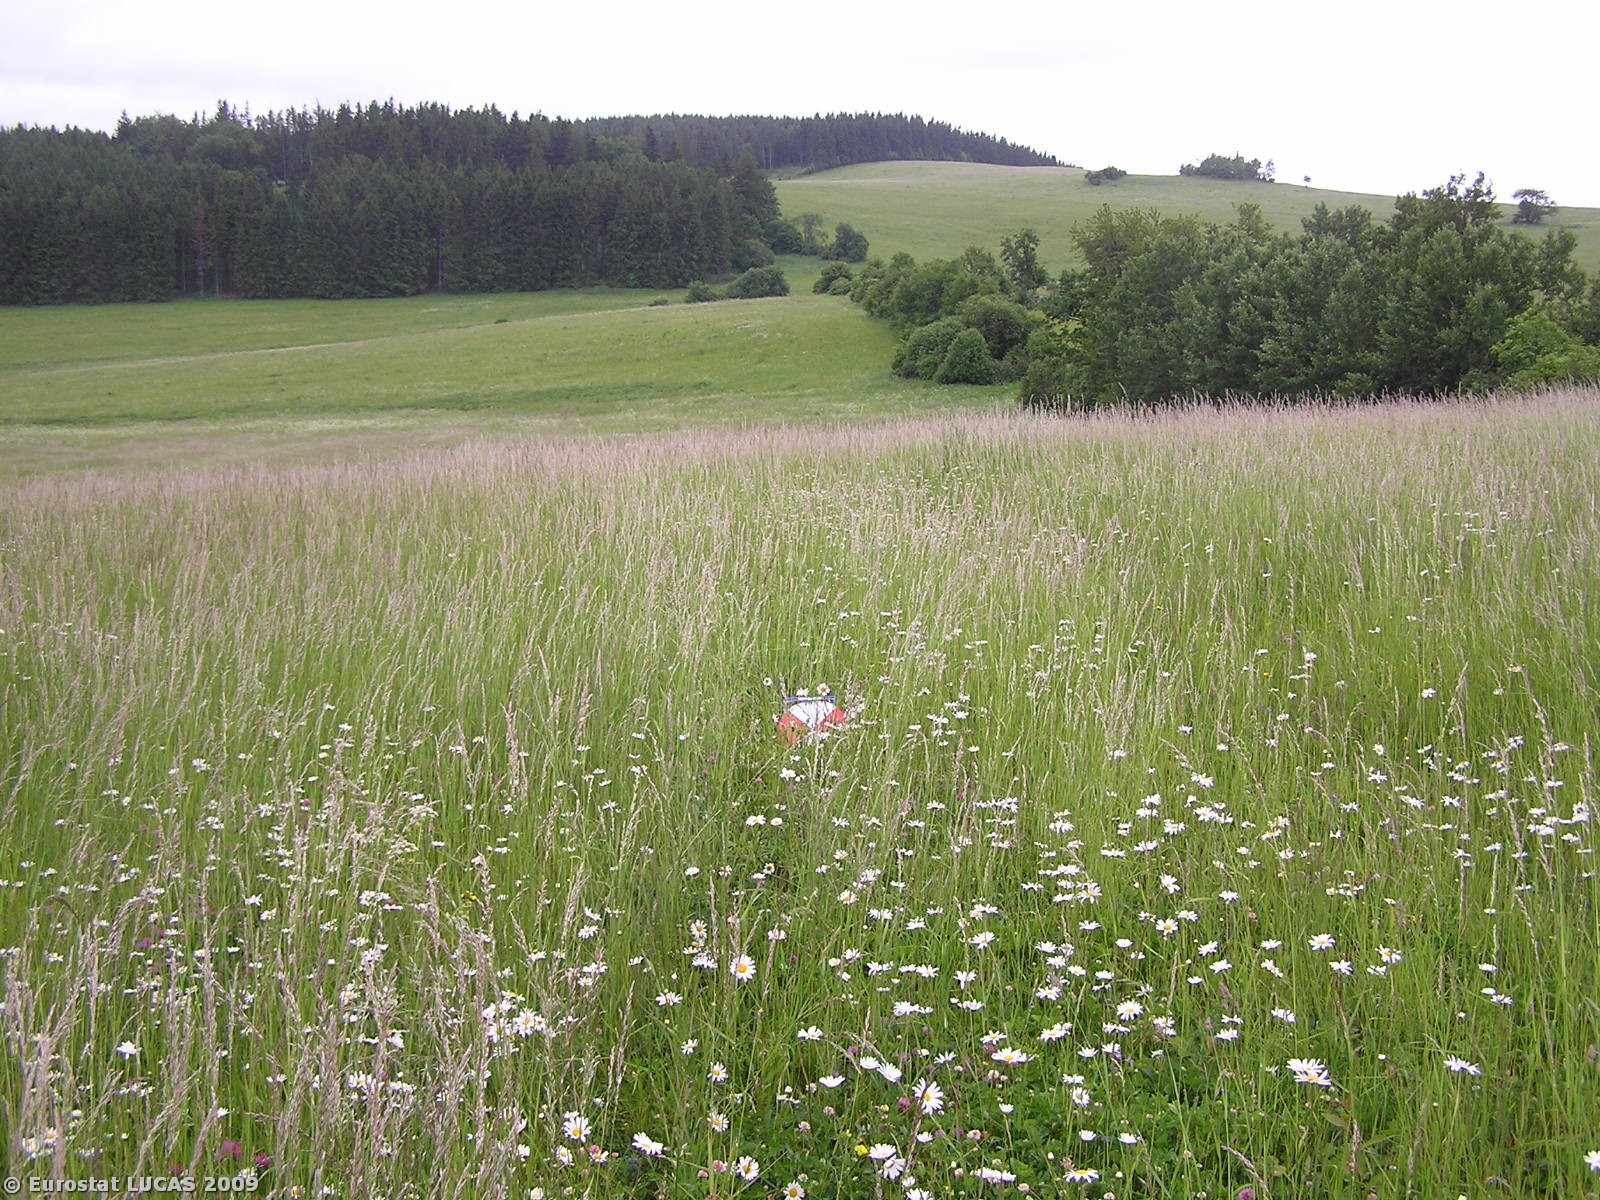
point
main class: Grassland
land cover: Grassland without tree/shrub cover
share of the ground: > 75 %
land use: Agriculture (excluding fallow land and kitchen gardens)
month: June
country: CZ
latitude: 50.0502
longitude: 17.4278
